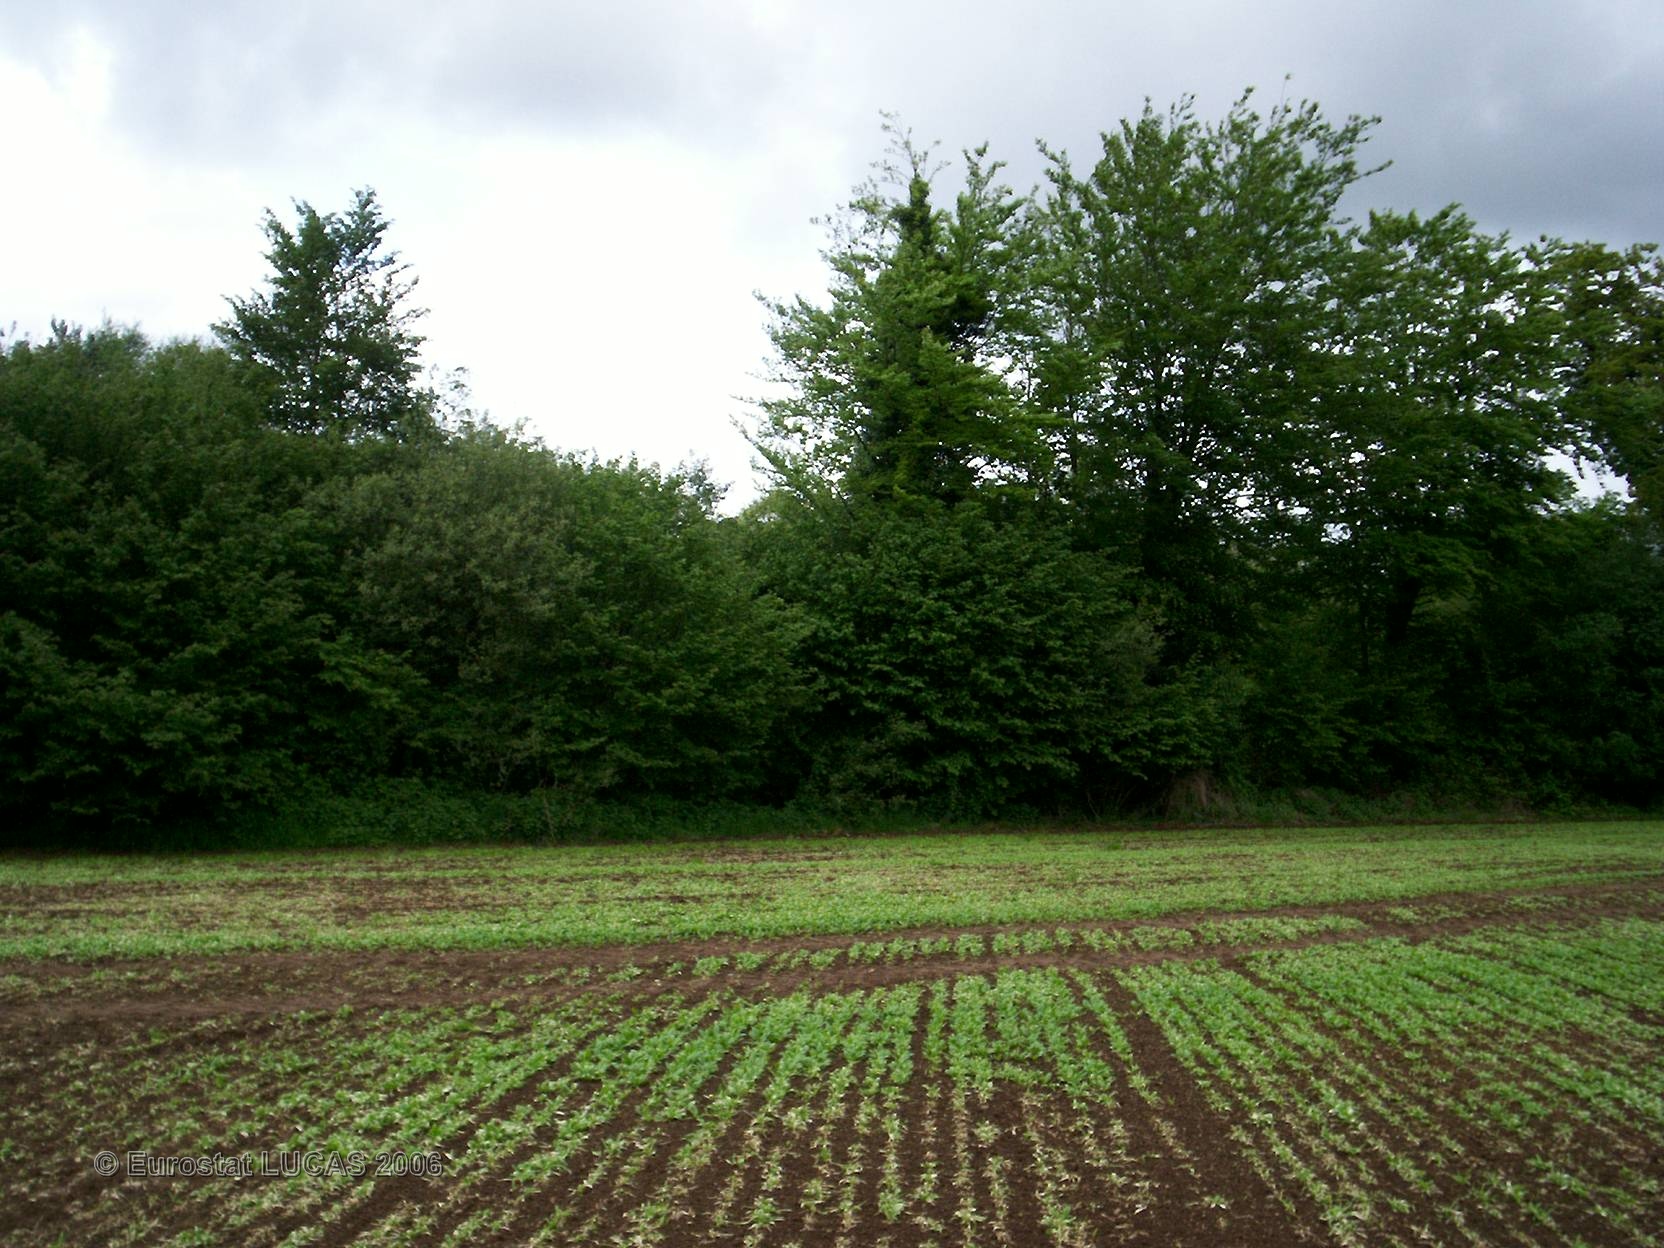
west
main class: Cropland
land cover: Other fresh vegetables
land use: Agriculture (excluding fallow land and kitchen gardens)
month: May
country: FR
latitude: 48.1472
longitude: -3.5596
